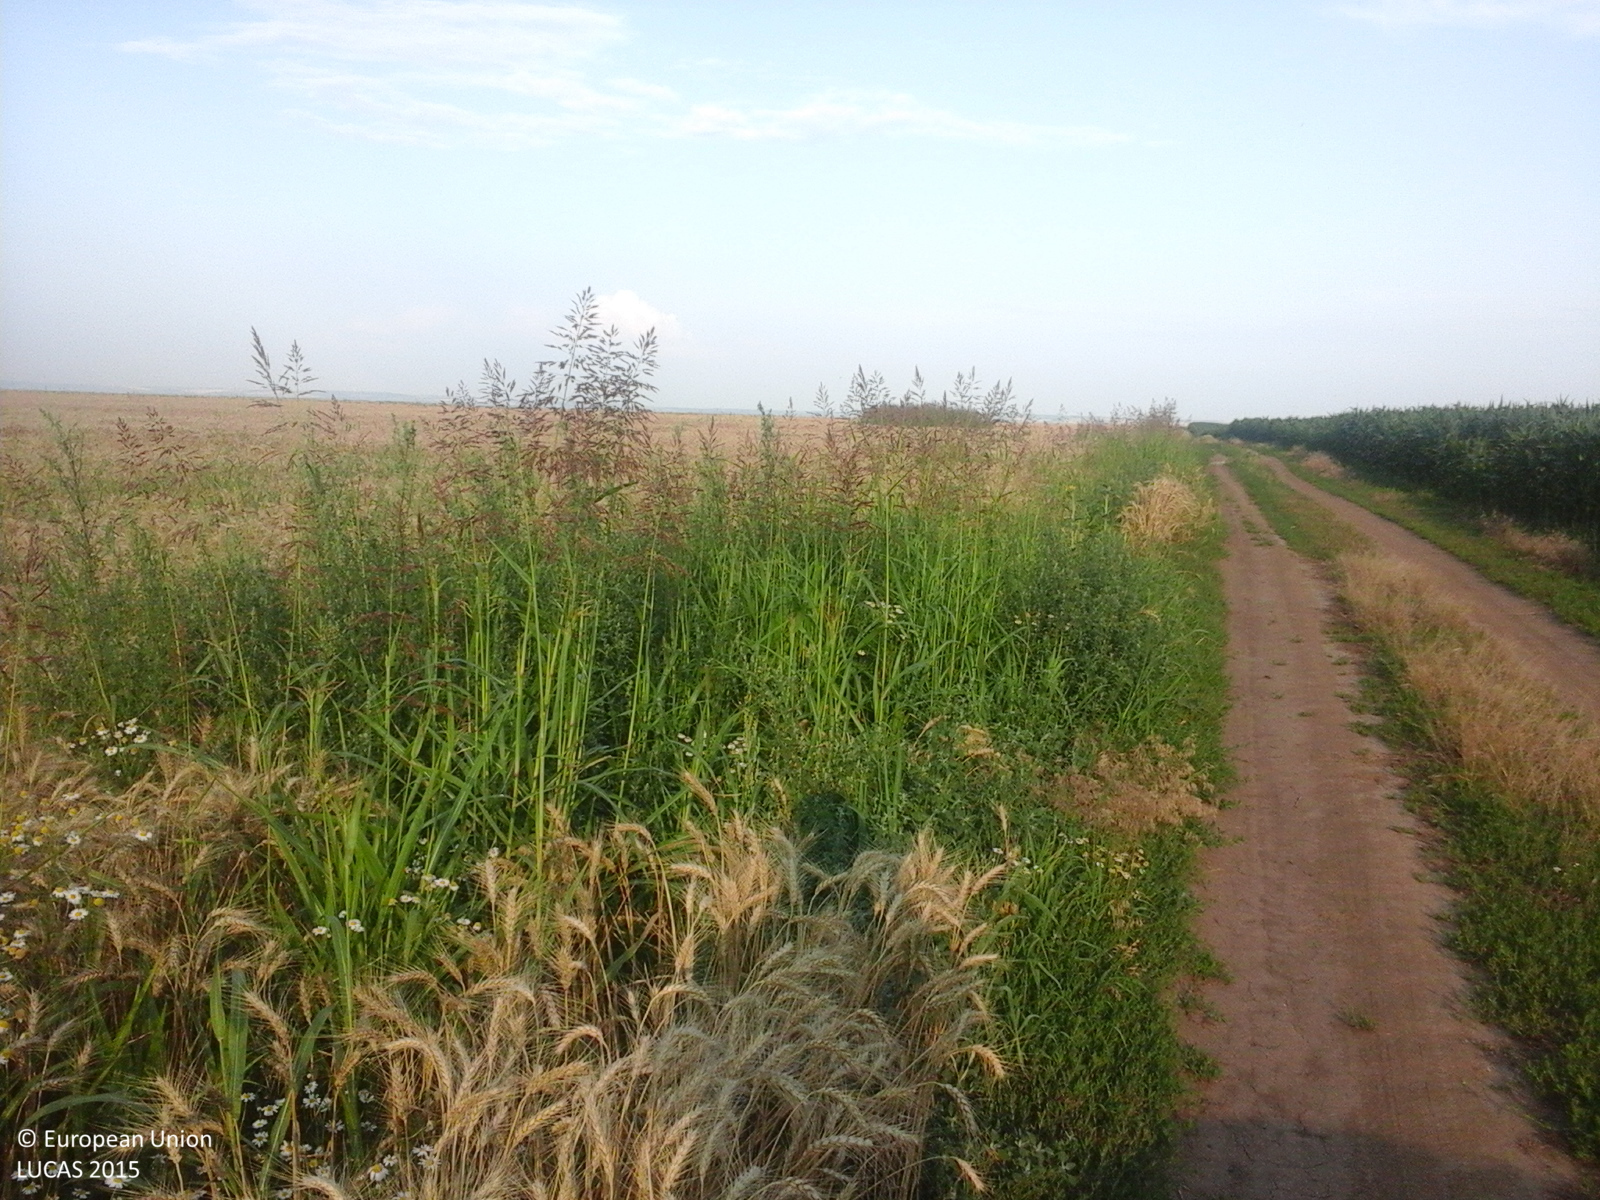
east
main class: Cropland
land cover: Common wheat
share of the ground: > 75 %
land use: Agriculture (excluding fallow land and kitchen gardens)
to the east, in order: Common wheat
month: July
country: RO
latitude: 43.7318
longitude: 25.5925
